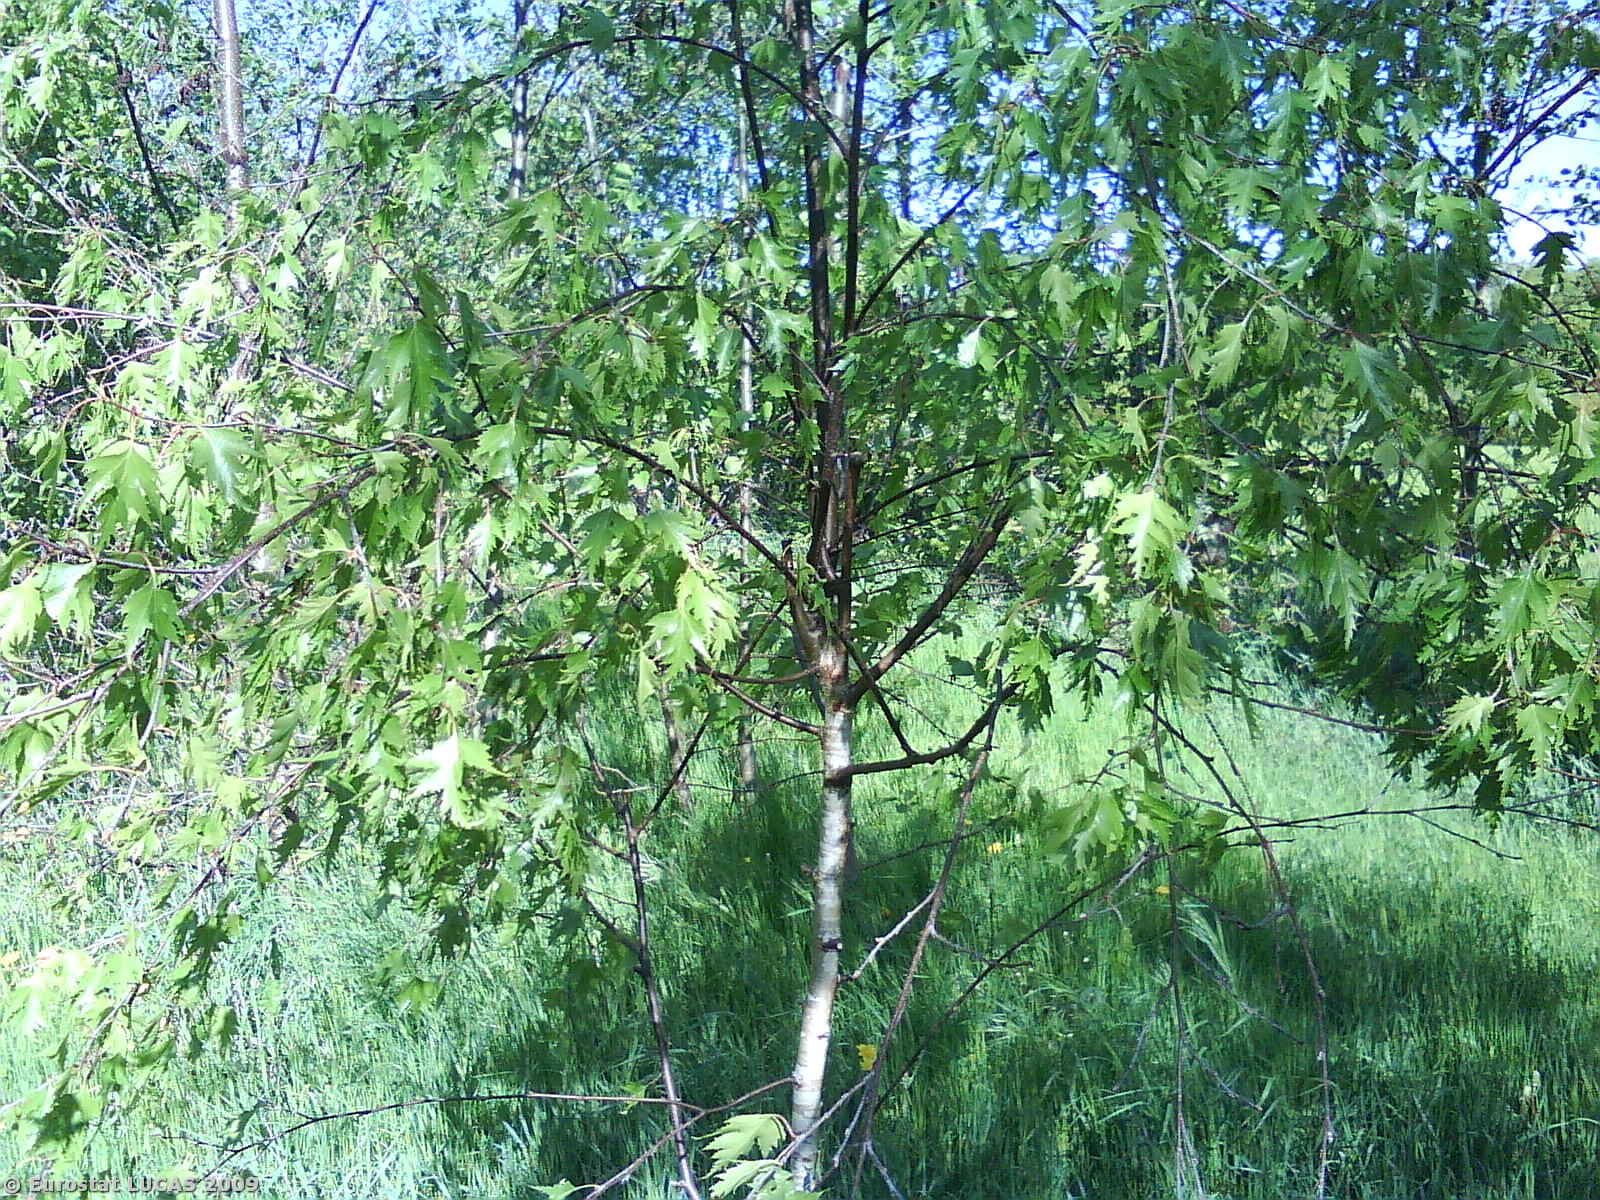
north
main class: Woodland
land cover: Broadleaved woodland
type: plantations and self-sown exotic forest
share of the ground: 25 - 50 %
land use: Unused
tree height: > 5 m
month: May
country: DK
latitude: 56.3473
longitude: 10.7595
